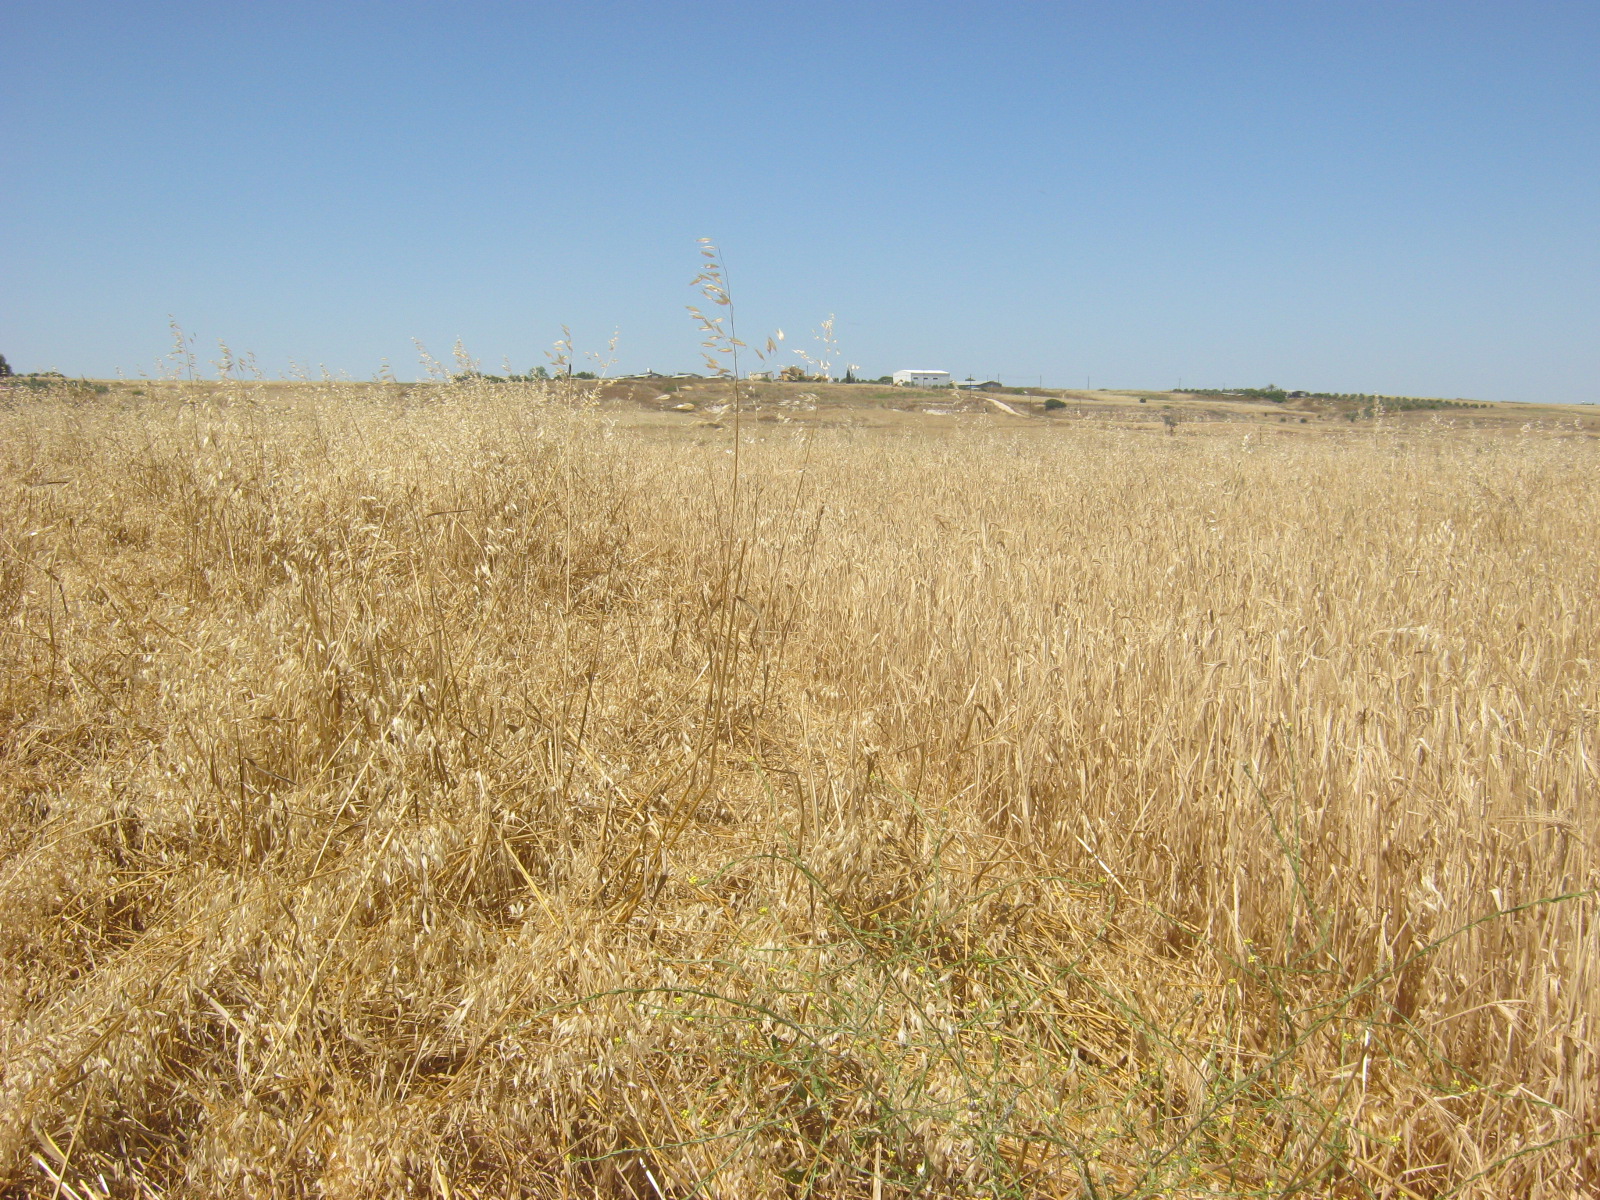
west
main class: Cropland
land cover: Mixed cereals for fodder
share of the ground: > 75 %
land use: Agriculture (excluding fallow land and kitchen gardens)
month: May
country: CY
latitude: 35.1255
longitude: 33.2431
